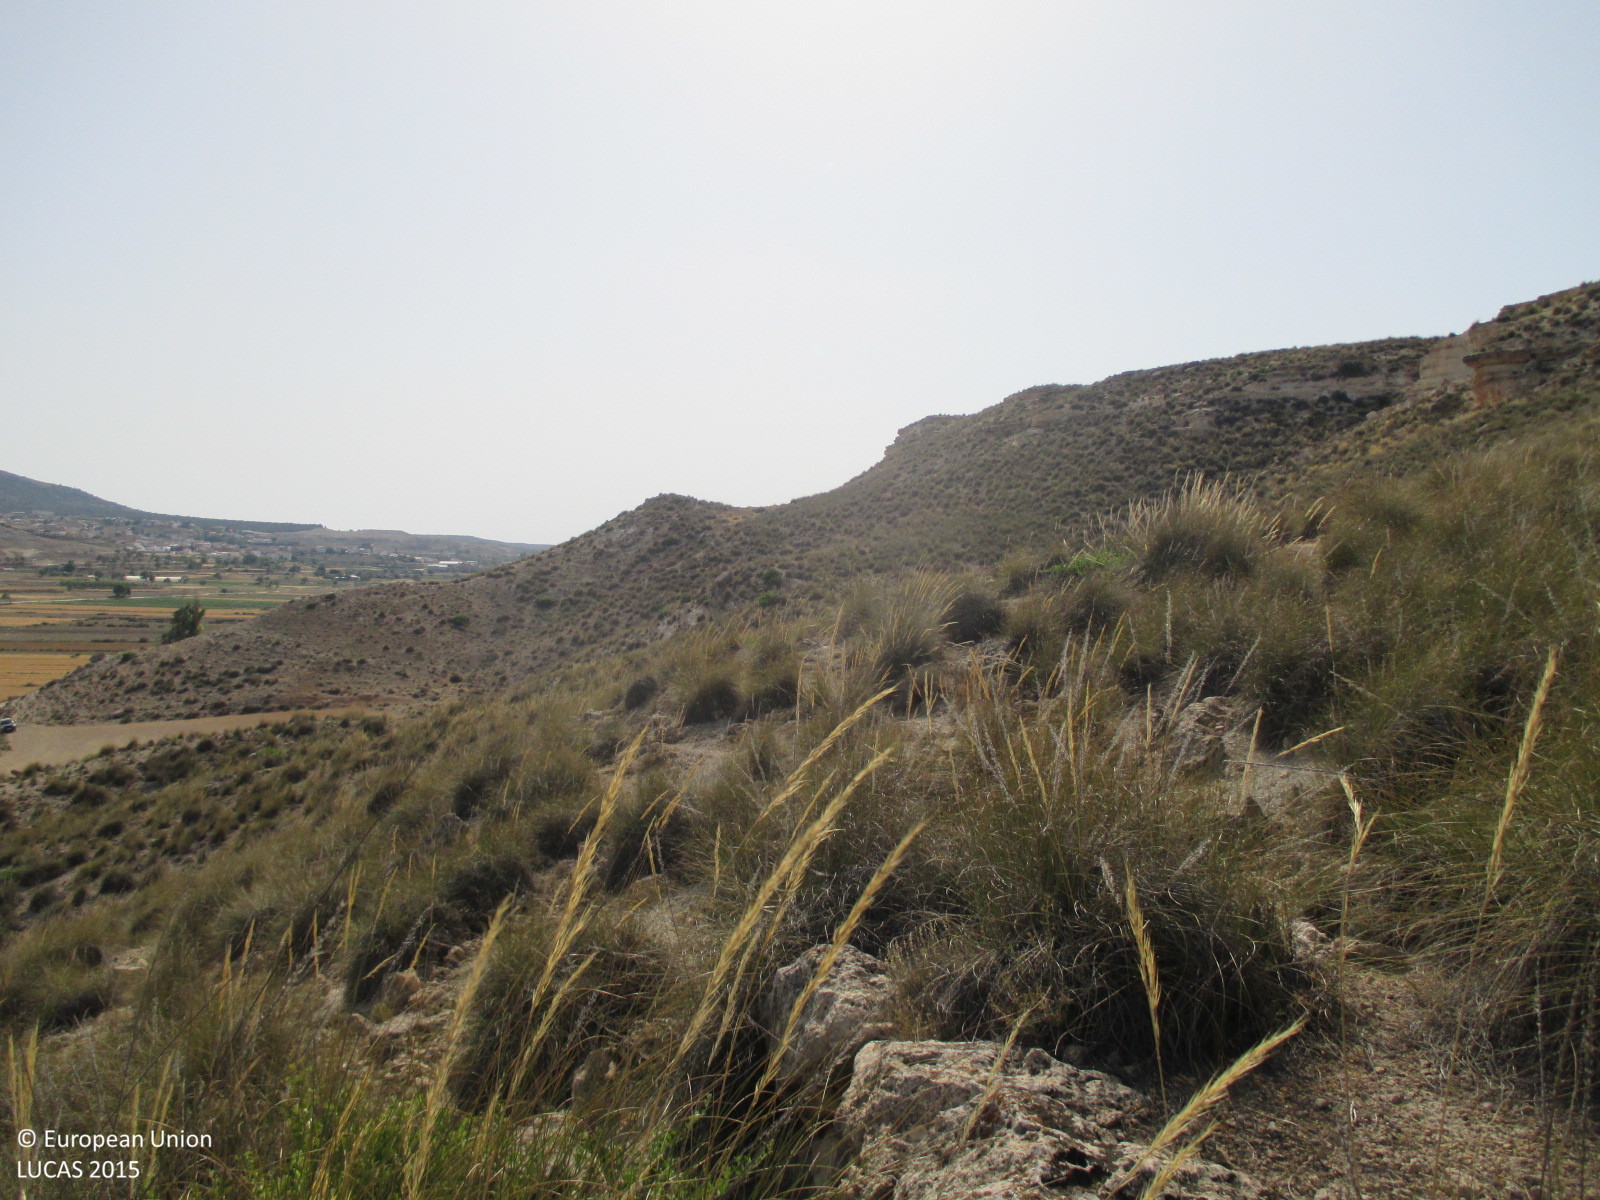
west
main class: Grassland
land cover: Grassland without tree/shrub cover
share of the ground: 50 - 75 %
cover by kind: herbaceous plants 55 %, unconsolidated bare surface 40 %, consolidated bare surface 5 %
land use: Semi-natural and natural areas not in use
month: June
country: ES
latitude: 37.7311
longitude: -2.4581
